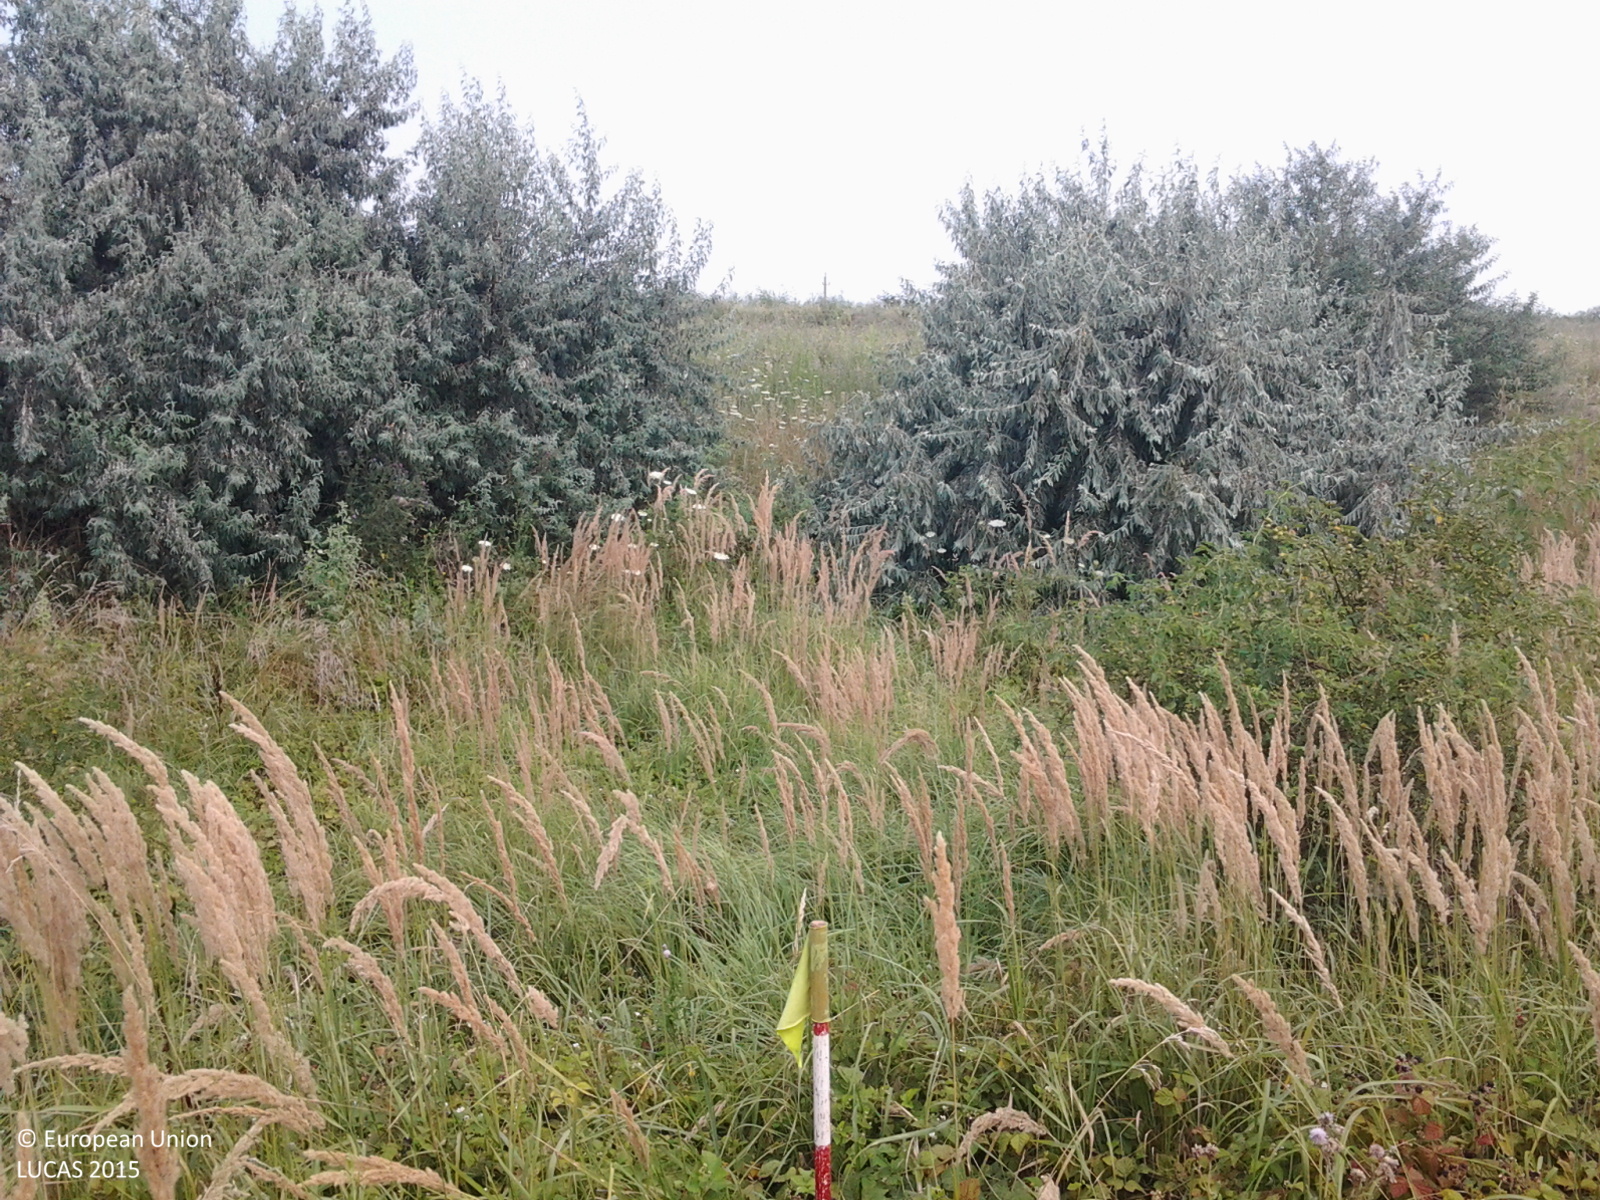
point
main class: Grassland
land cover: Grassland with sparse tree/shrub cover
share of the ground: > 75 %
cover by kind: herbaceous plants 85 %, shrubs 10 %, broadleaved forest trees 5 %
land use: Semi-natural and natural areas not in use
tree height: < 5 m
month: July
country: HU
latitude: 47.1083
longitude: 20.4524
